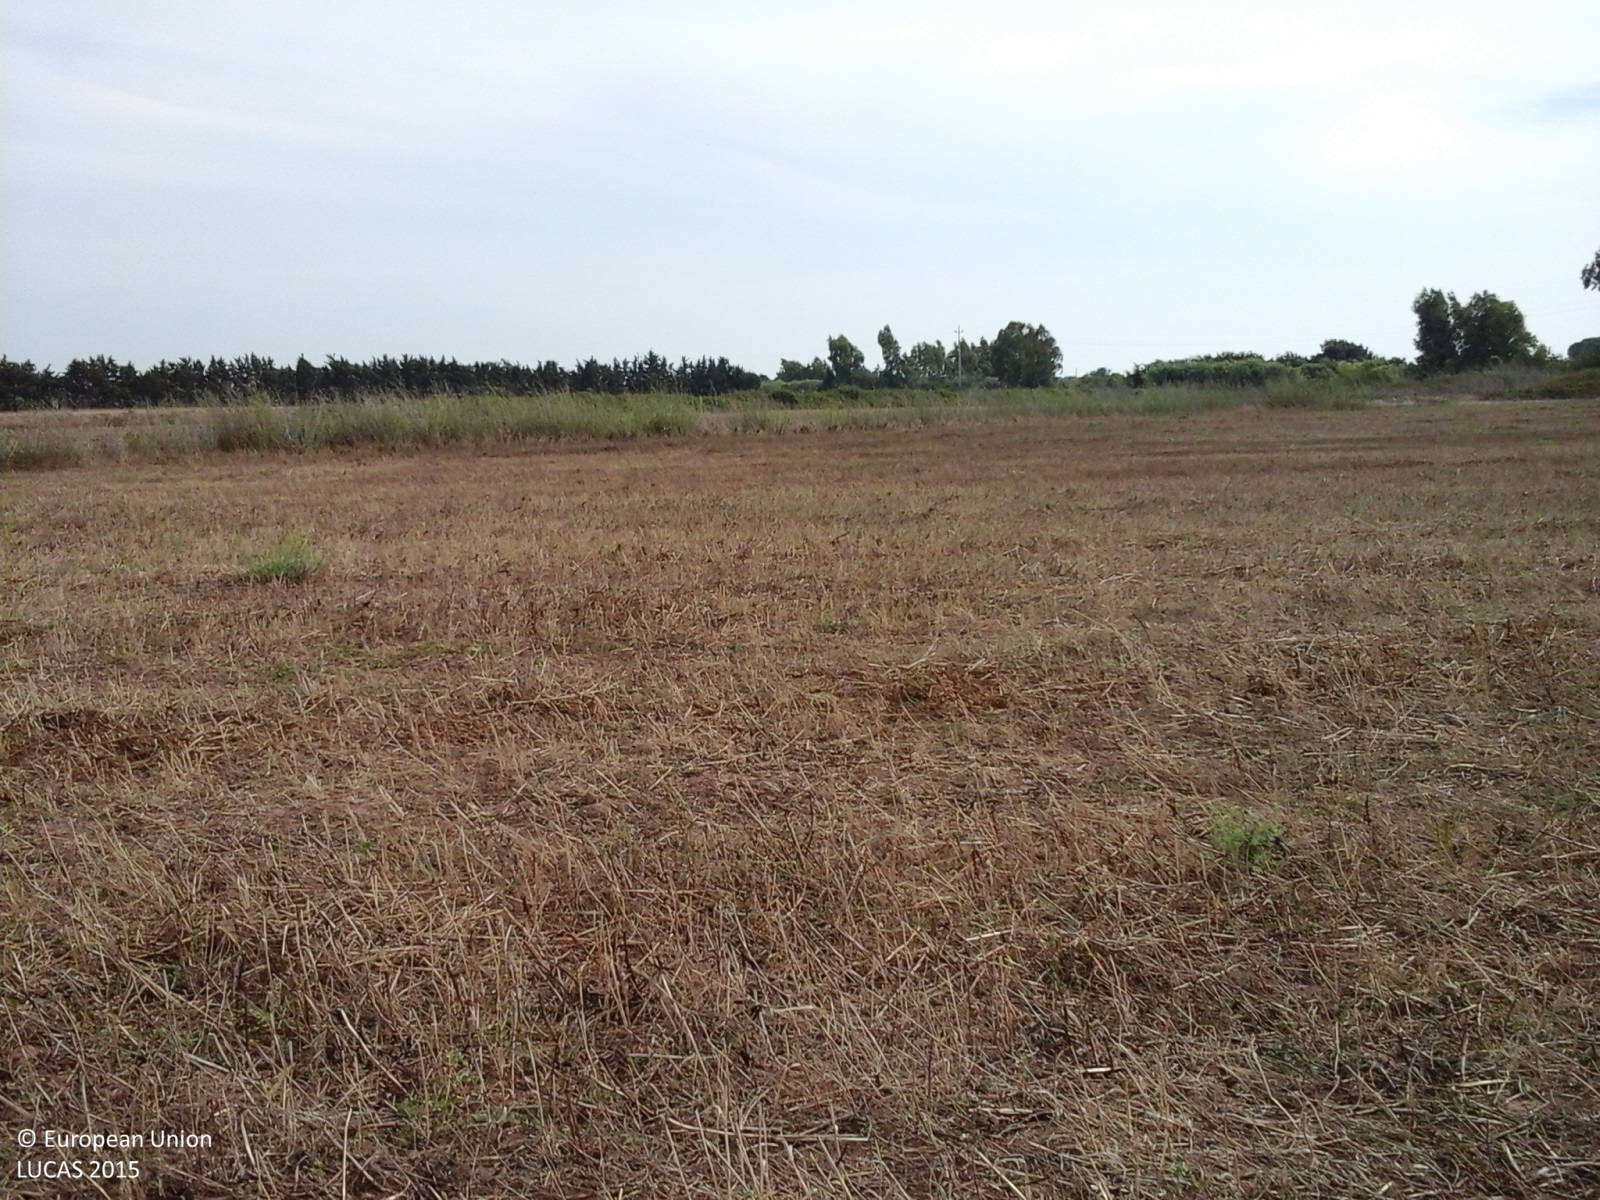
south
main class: Cropland
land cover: Temporary grasslands
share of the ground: > 75 %
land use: Agriculture (excluding fallow land and kitchen gardens)
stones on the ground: < 10 %
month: August
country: IT
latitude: 40.0208
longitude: 8.5200
